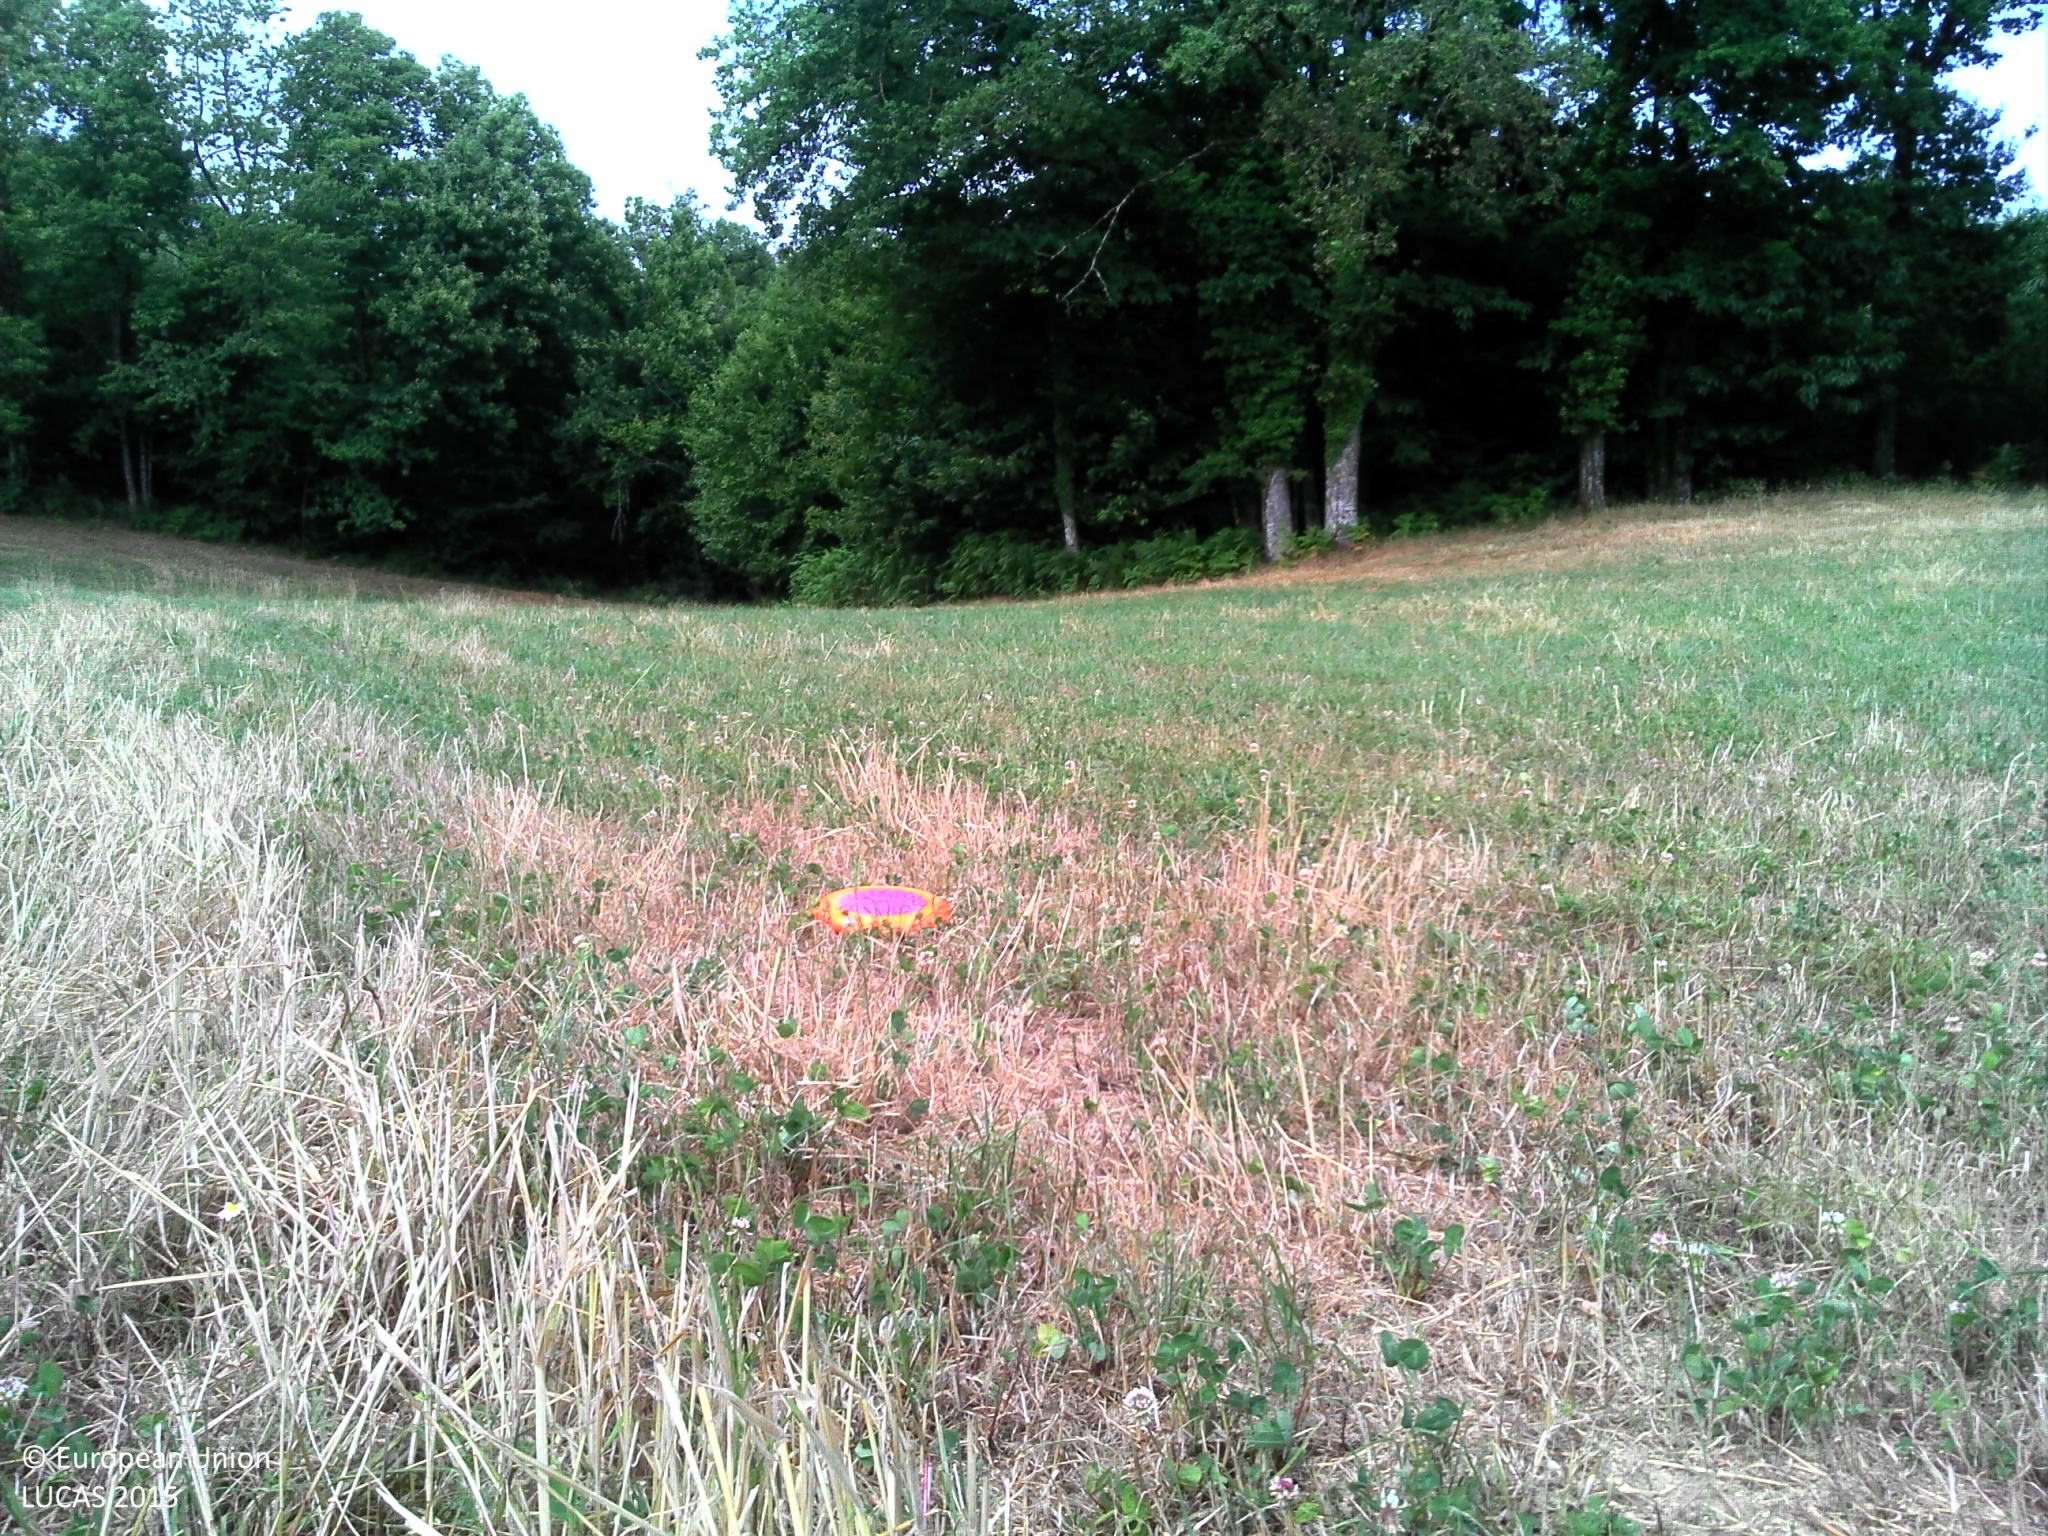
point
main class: Grassland
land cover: Grassland without tree/shrub cover
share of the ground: > 75 %
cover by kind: herbaceous plants 100 %
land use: Agriculture (excluding fallow land and kitchen gardens)
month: July
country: FR
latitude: 45.6647
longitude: 1.0182
